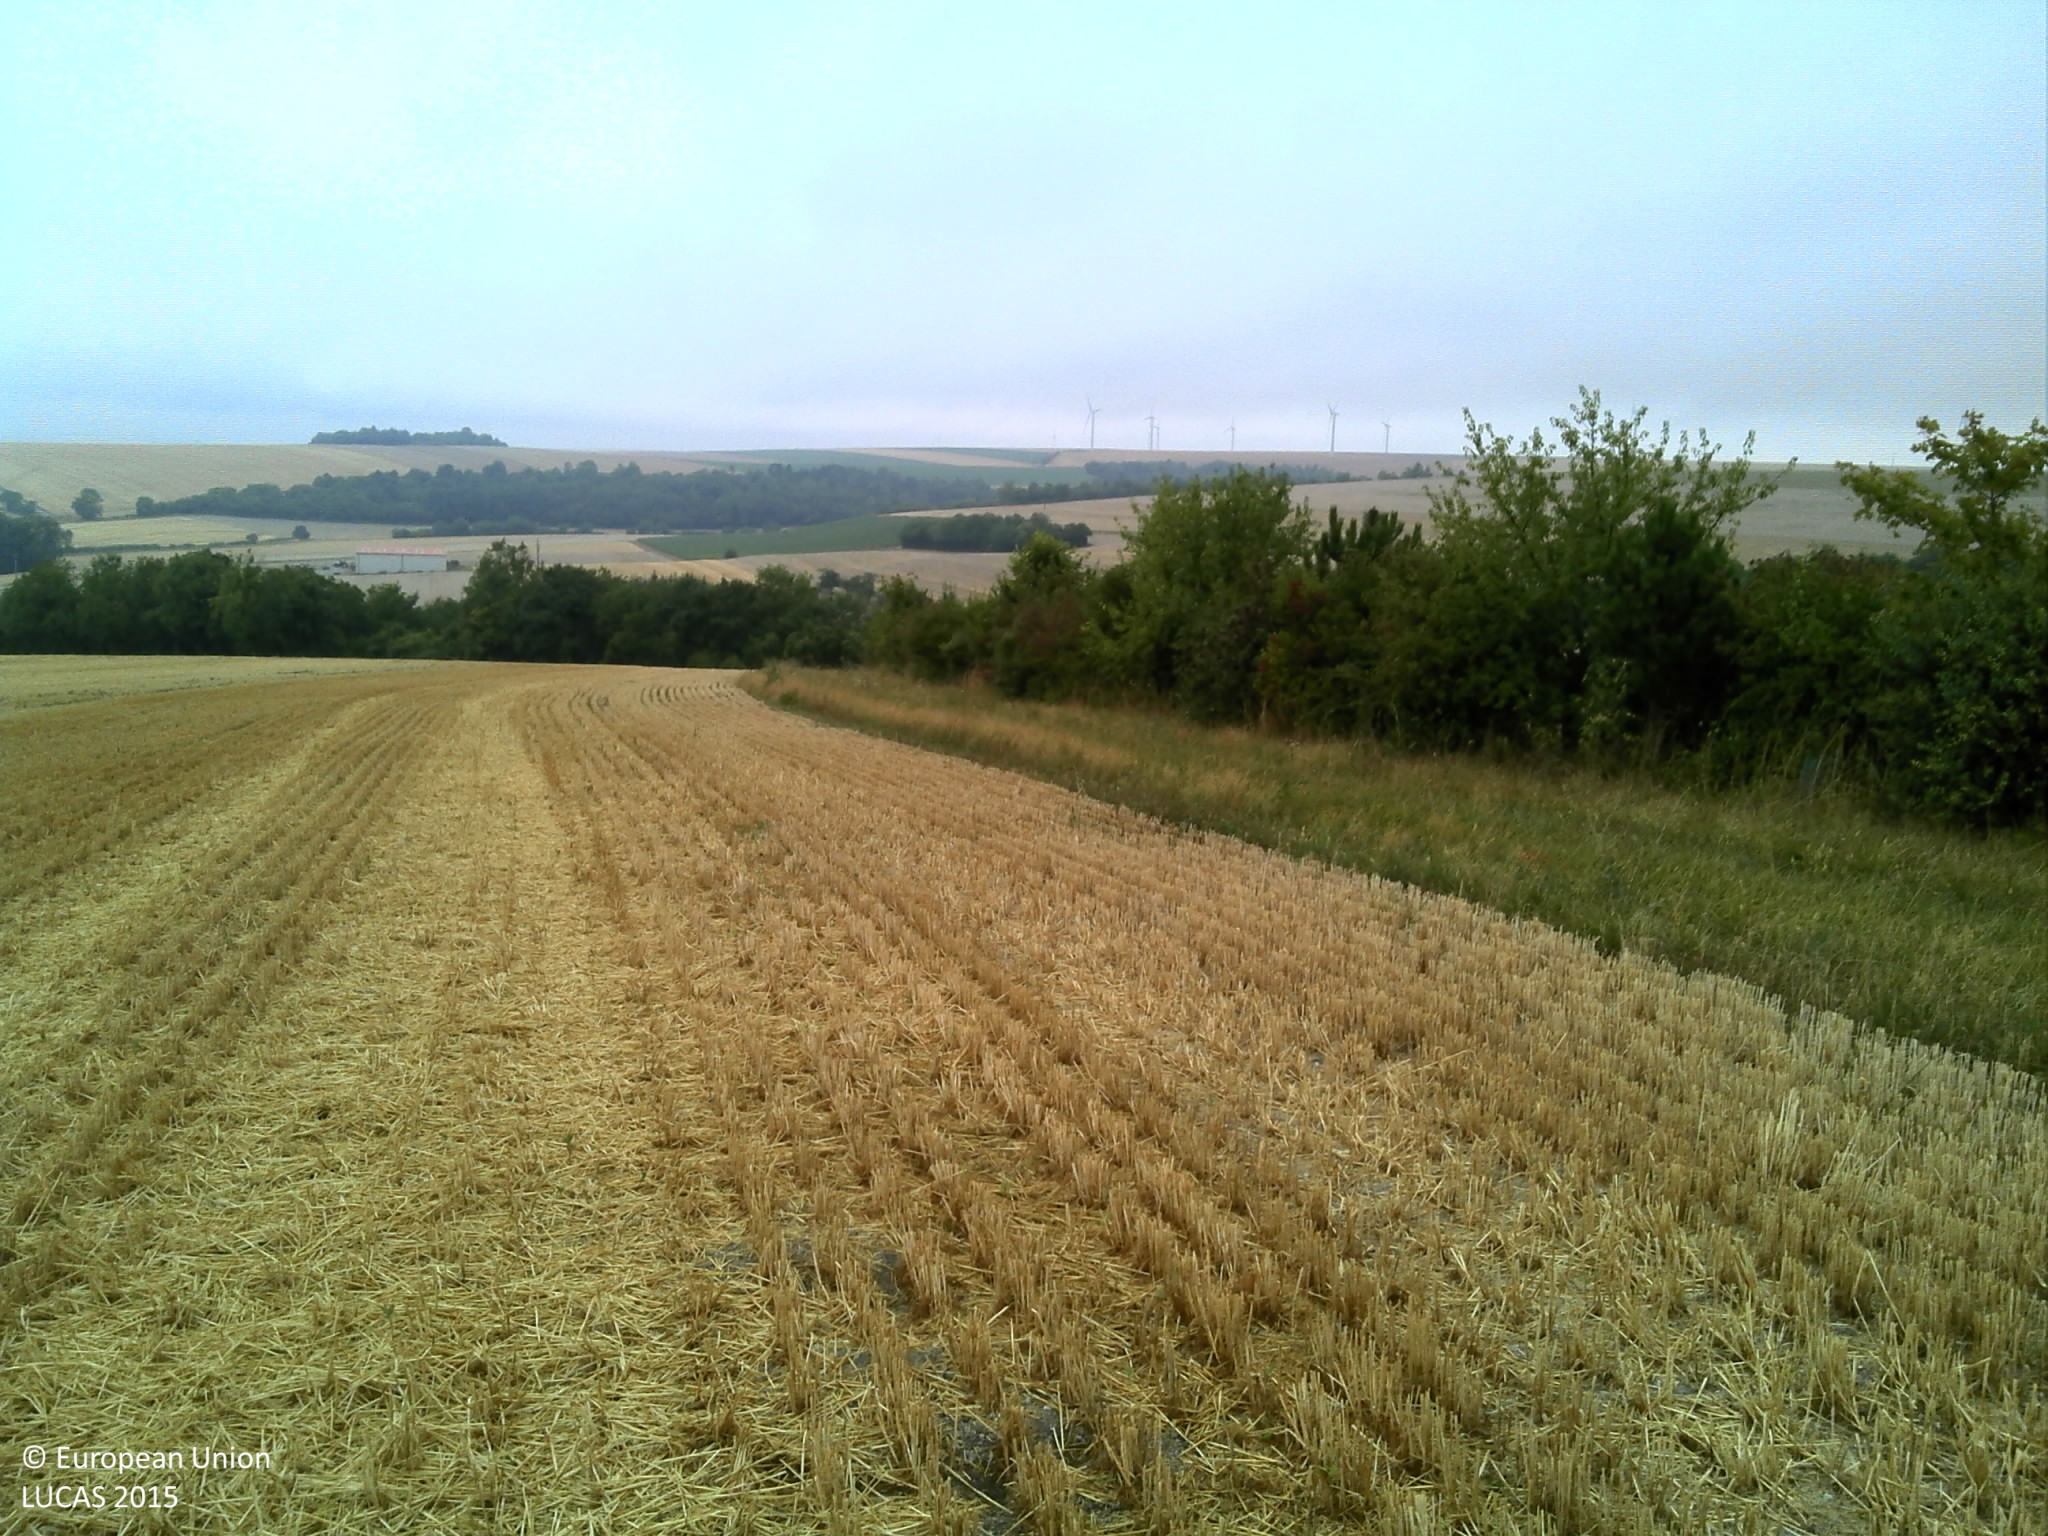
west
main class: Cropland
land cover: Barley
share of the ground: > 75 %
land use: Agriculture (excluding fallow land and kitchen gardens)
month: July
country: FR
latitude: 48.8352
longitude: 4.6976
